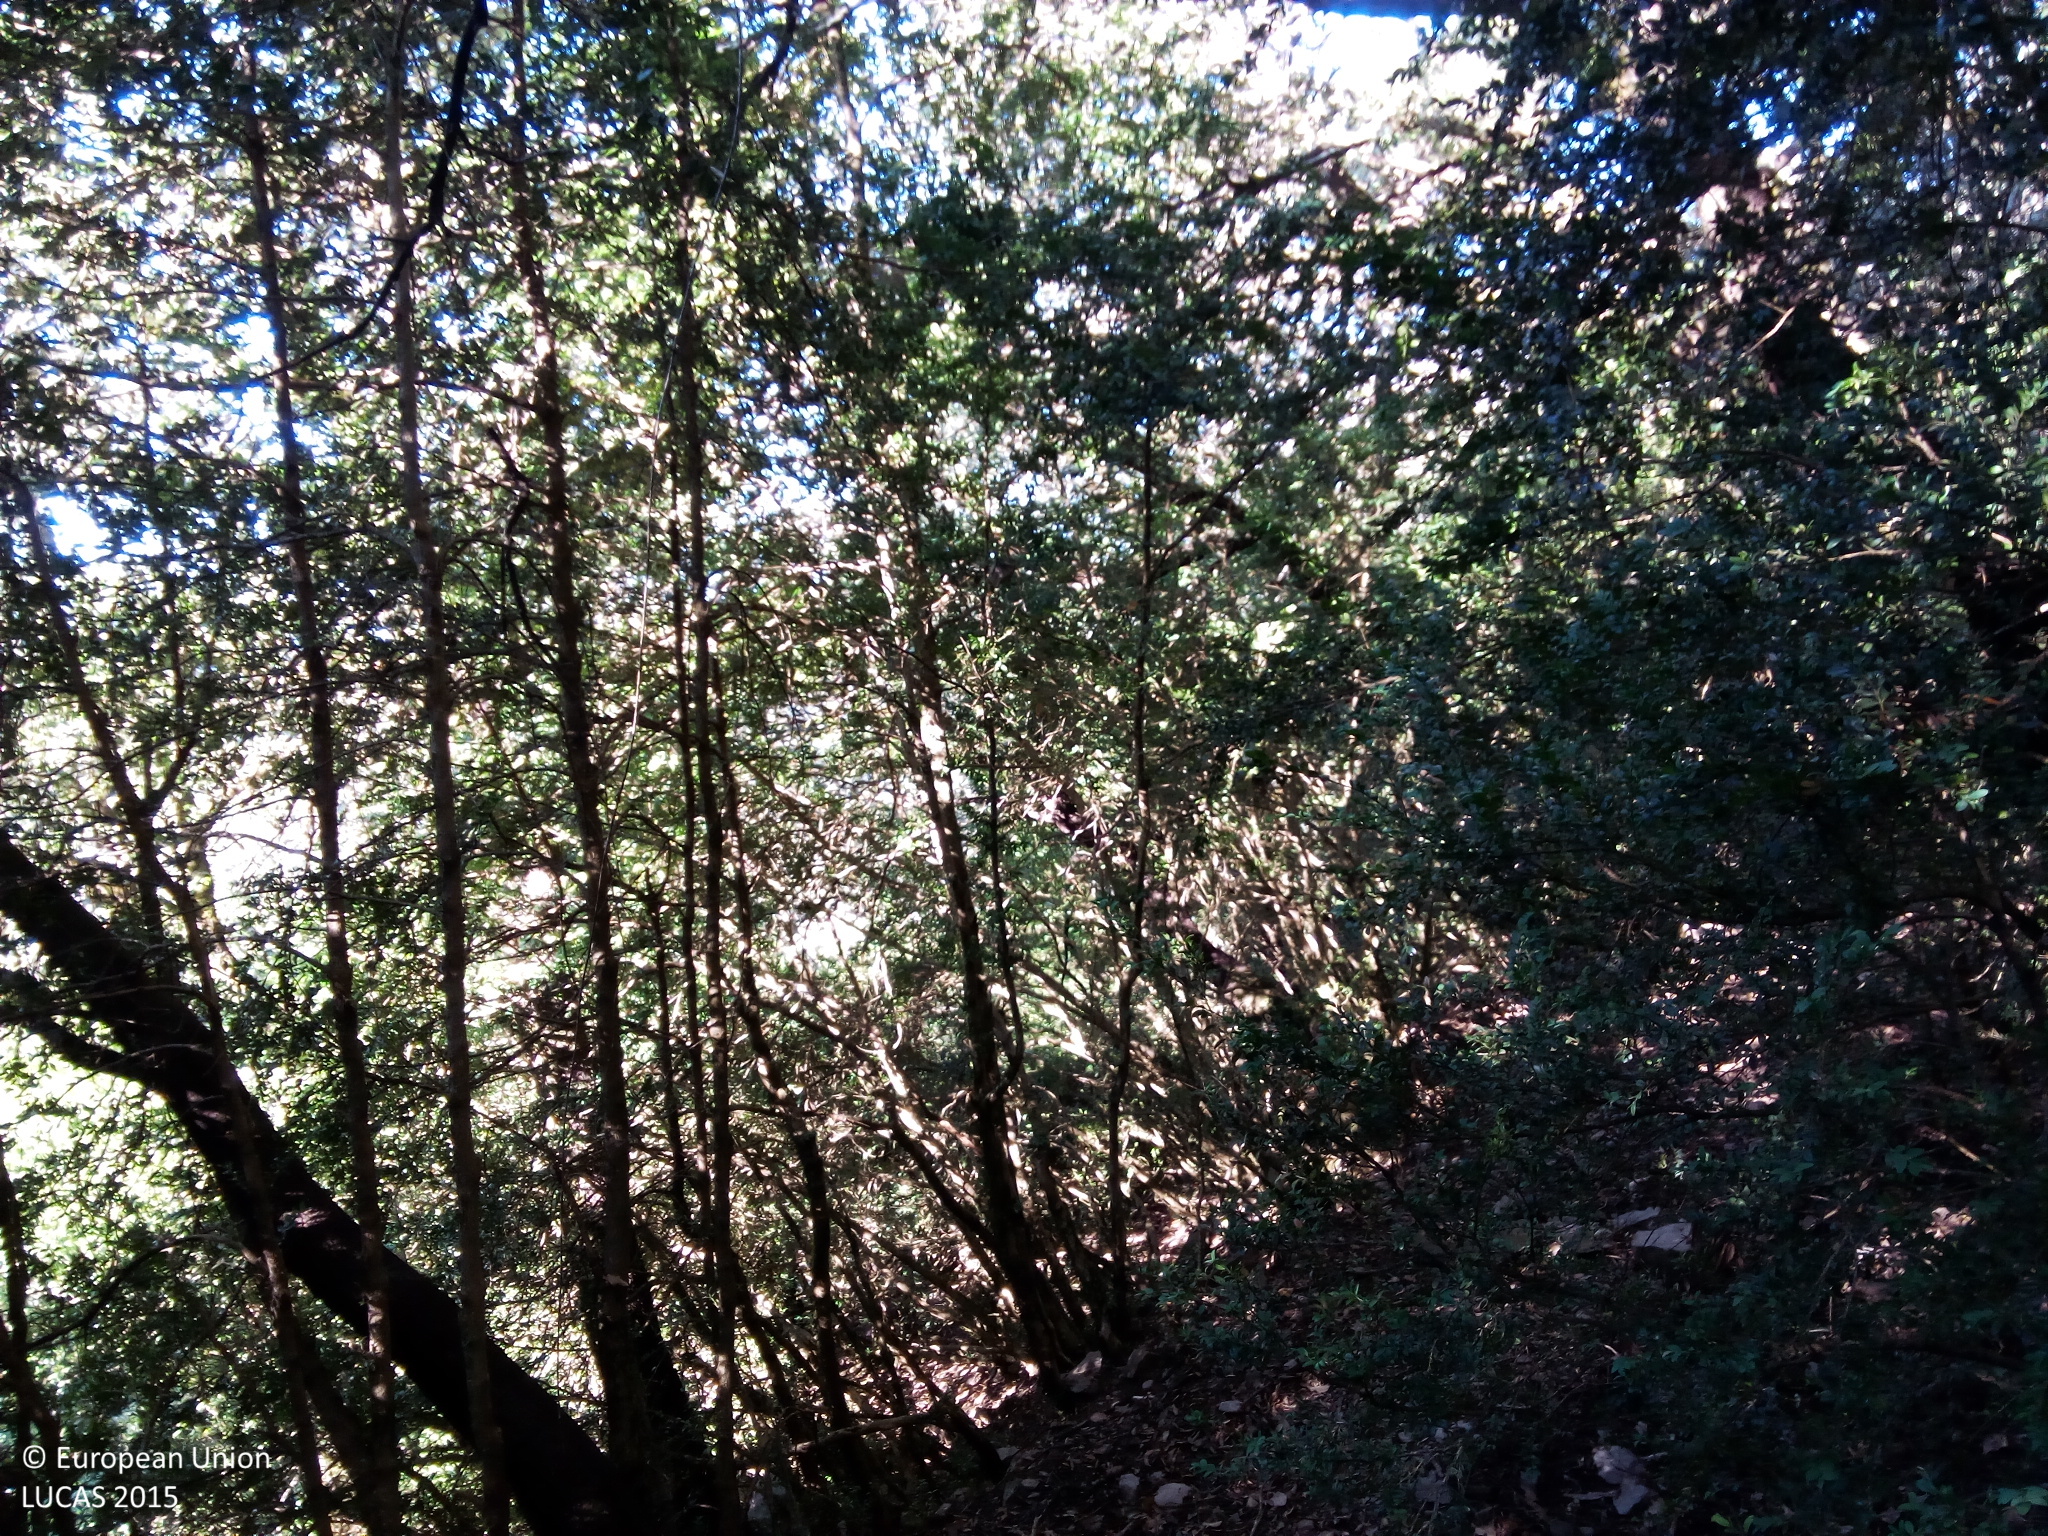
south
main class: Woodland
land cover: Broadleaved woodland
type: broadleaved evergreen forest
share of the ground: > 75 %
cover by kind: broadleaved forest trees 100 %
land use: Semi-natural and natural areas not in use
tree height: > 5 m
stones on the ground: 25 - 50 %
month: August
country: ES
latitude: 42.5926
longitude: 0.1675
